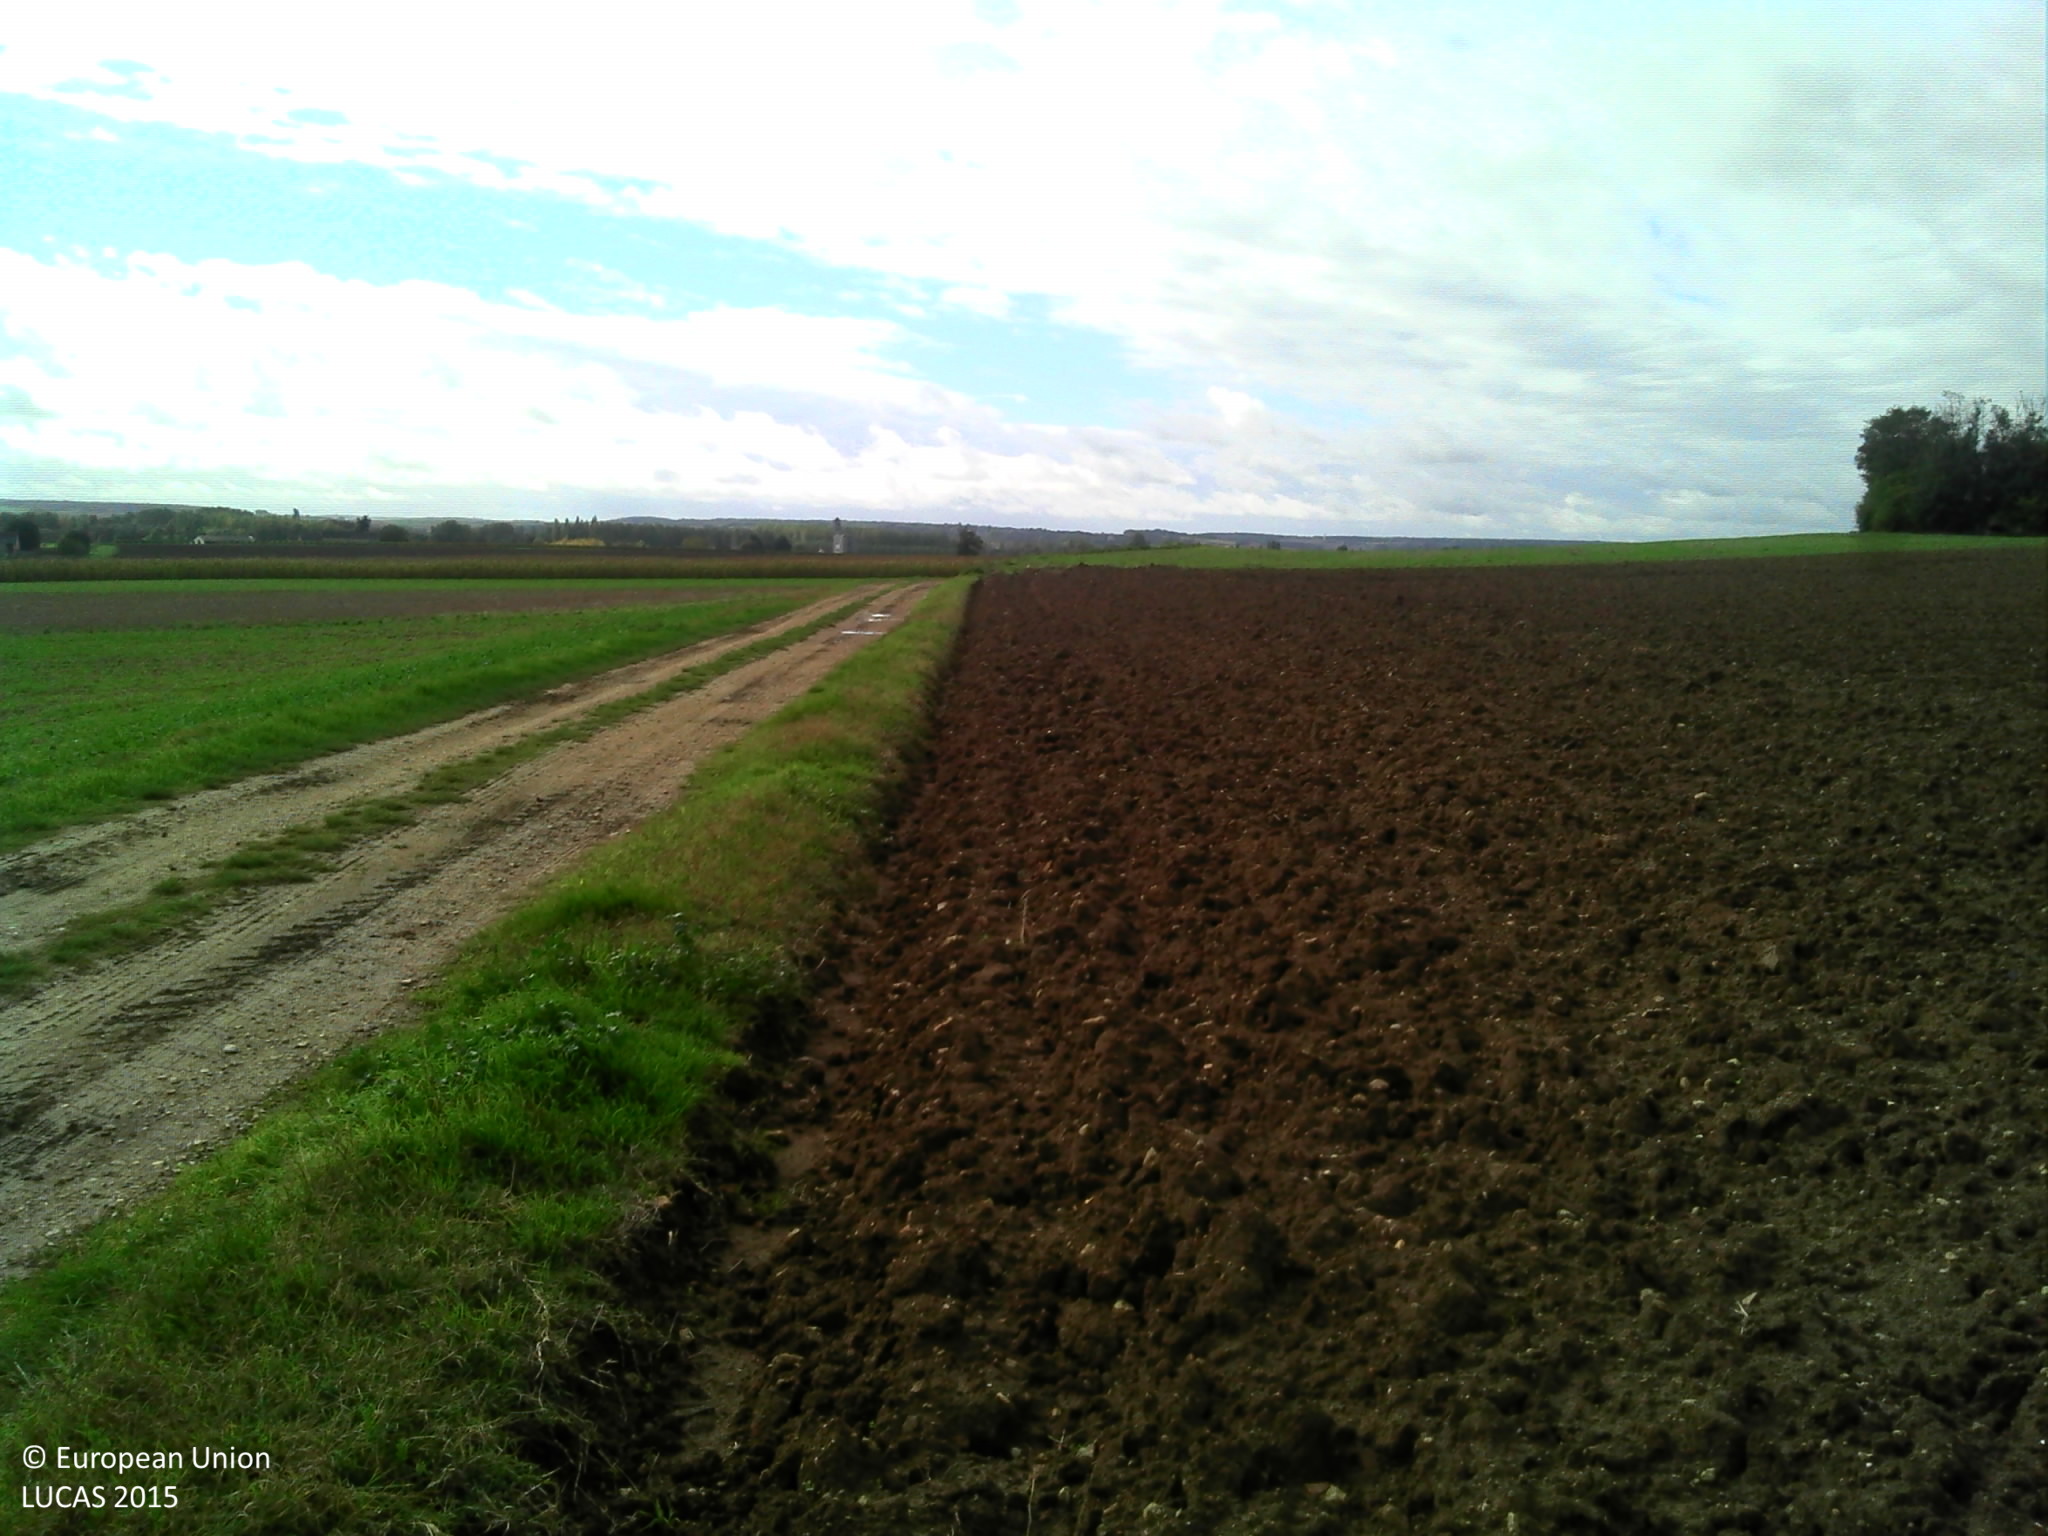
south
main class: Cropland
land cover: Other fibre and oleaginous crops
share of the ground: > 75 %
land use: Agriculture (excluding fallow land and kitchen gardens)
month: October
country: FR
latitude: 47.1551
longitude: 0.4436
